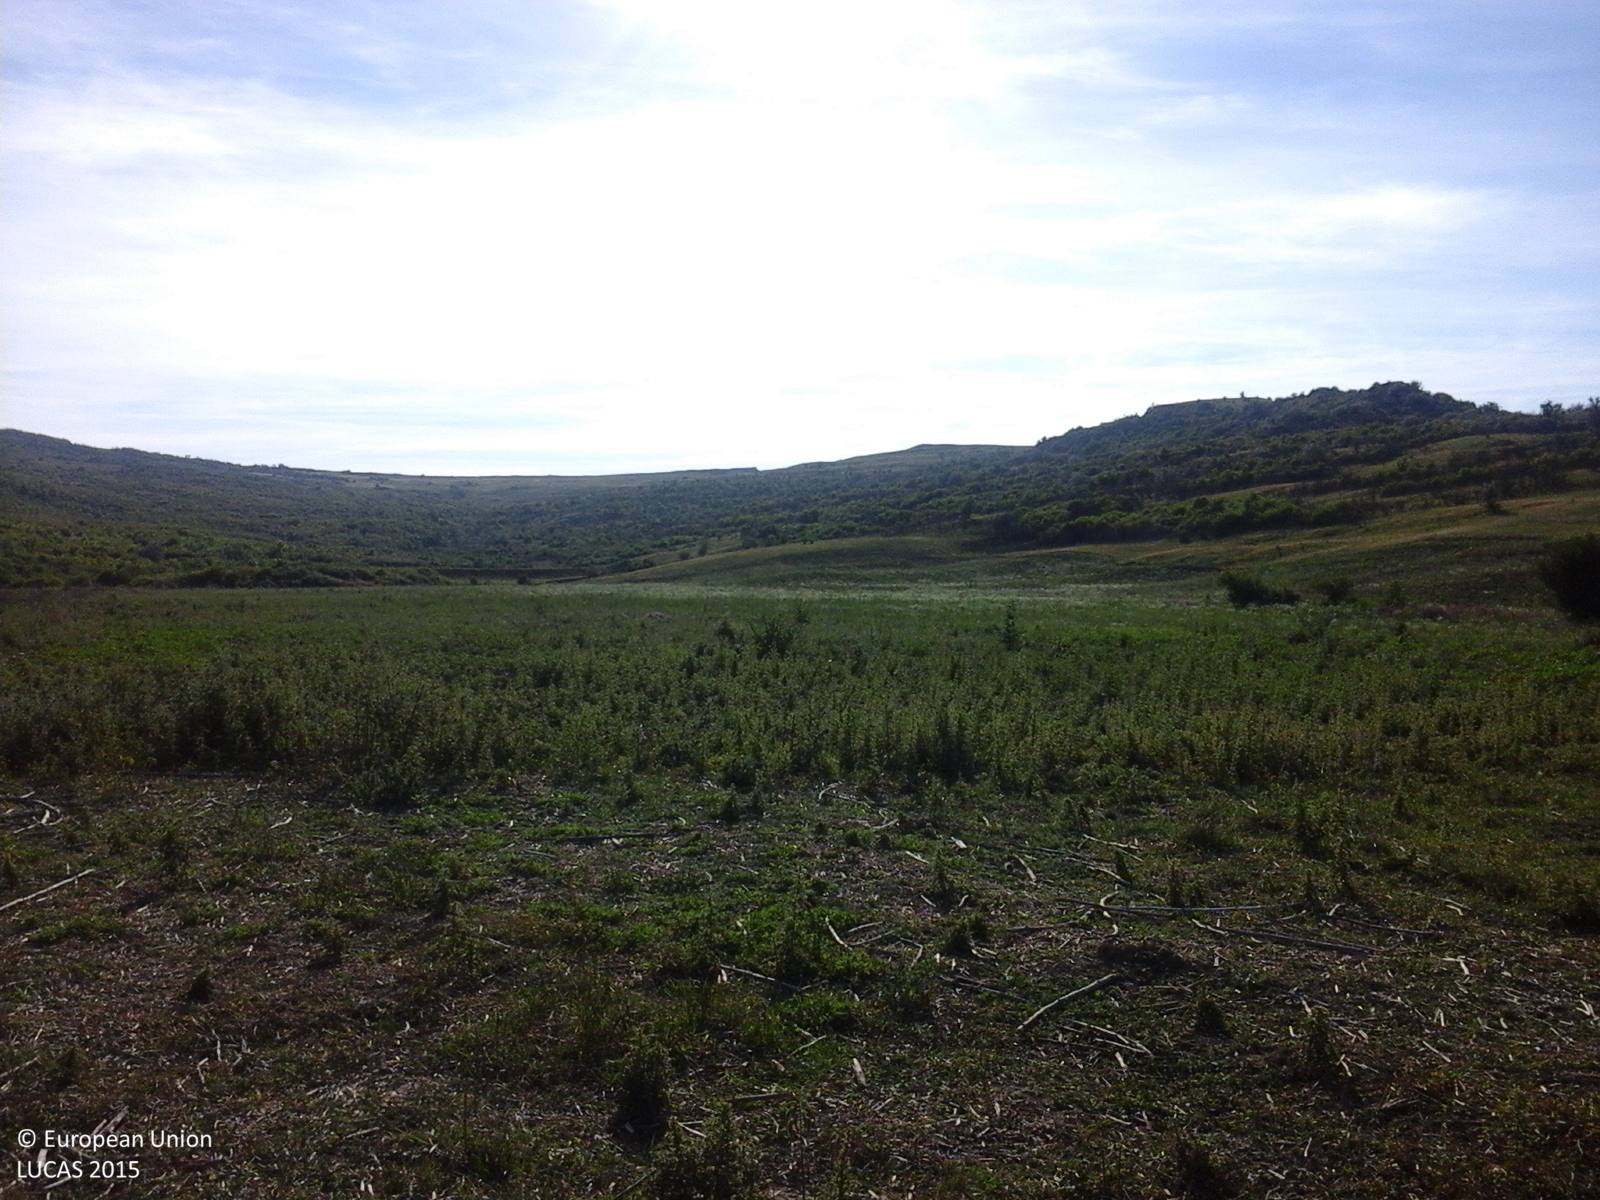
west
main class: Grassland
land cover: Spontaneously vegetated surfaces
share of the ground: > 75 %
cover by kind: herbaceous plants 100 %
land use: Agriculture (excluding fallow land and kitchen gardens)
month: June
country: RO
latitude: 47.1269
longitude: 27.0139
